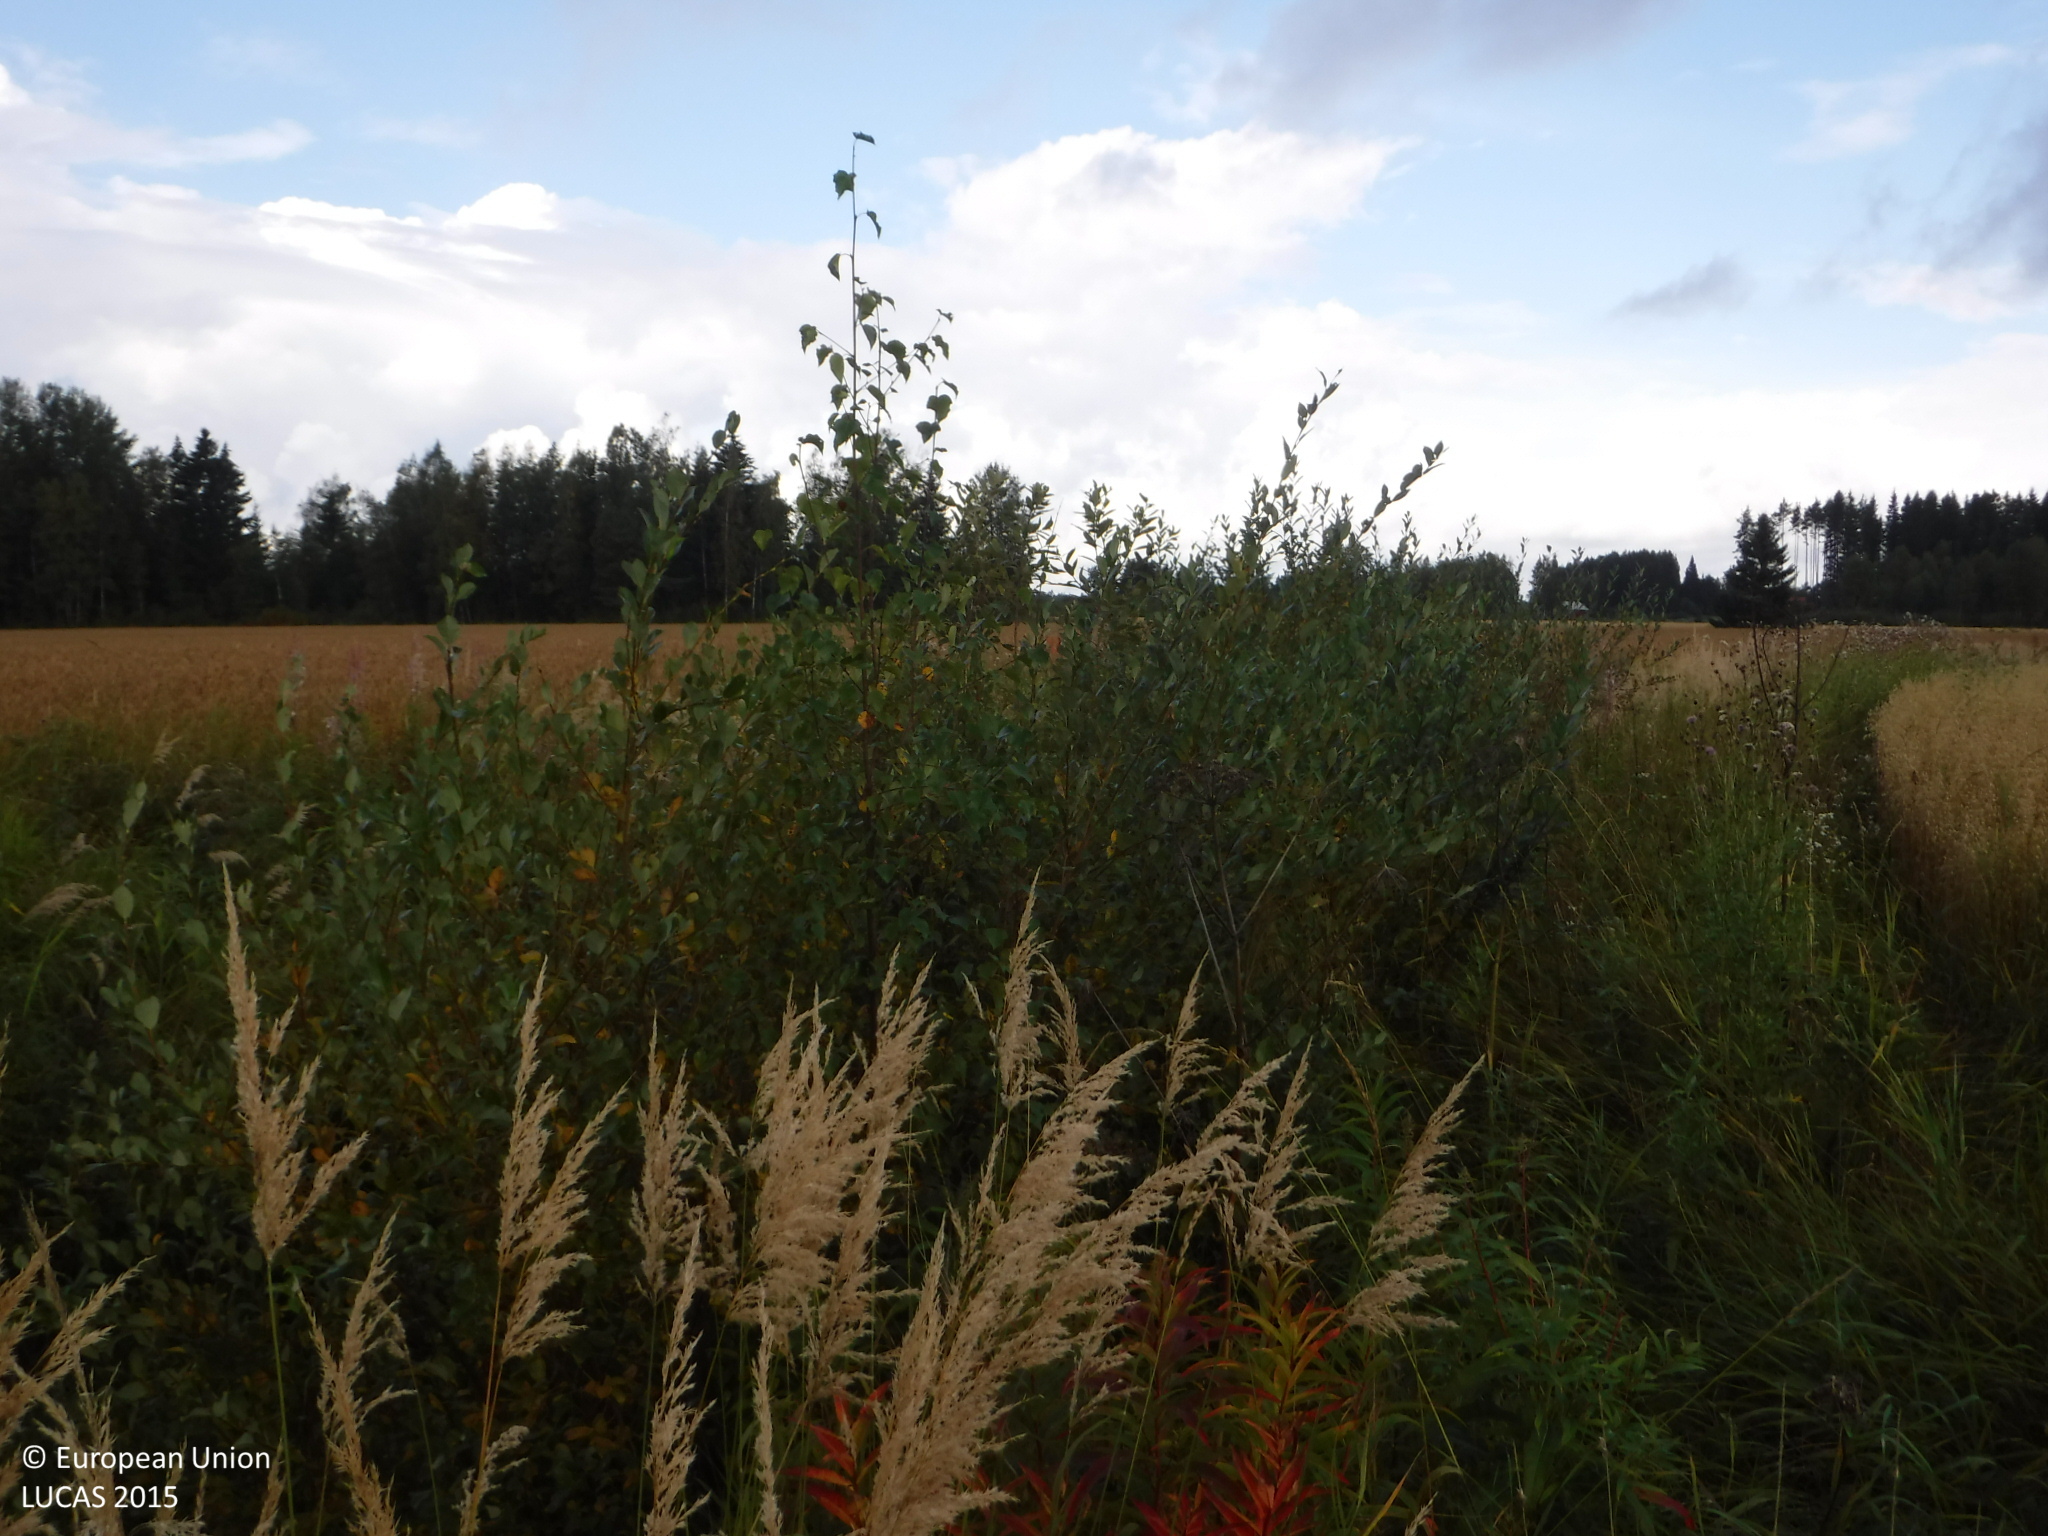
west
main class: Cropland
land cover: Common wheat
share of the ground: > 75 %
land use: Agriculture (excluding fallow land and kitchen gardens)
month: September
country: FI
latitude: 61.3189
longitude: 22.5235
